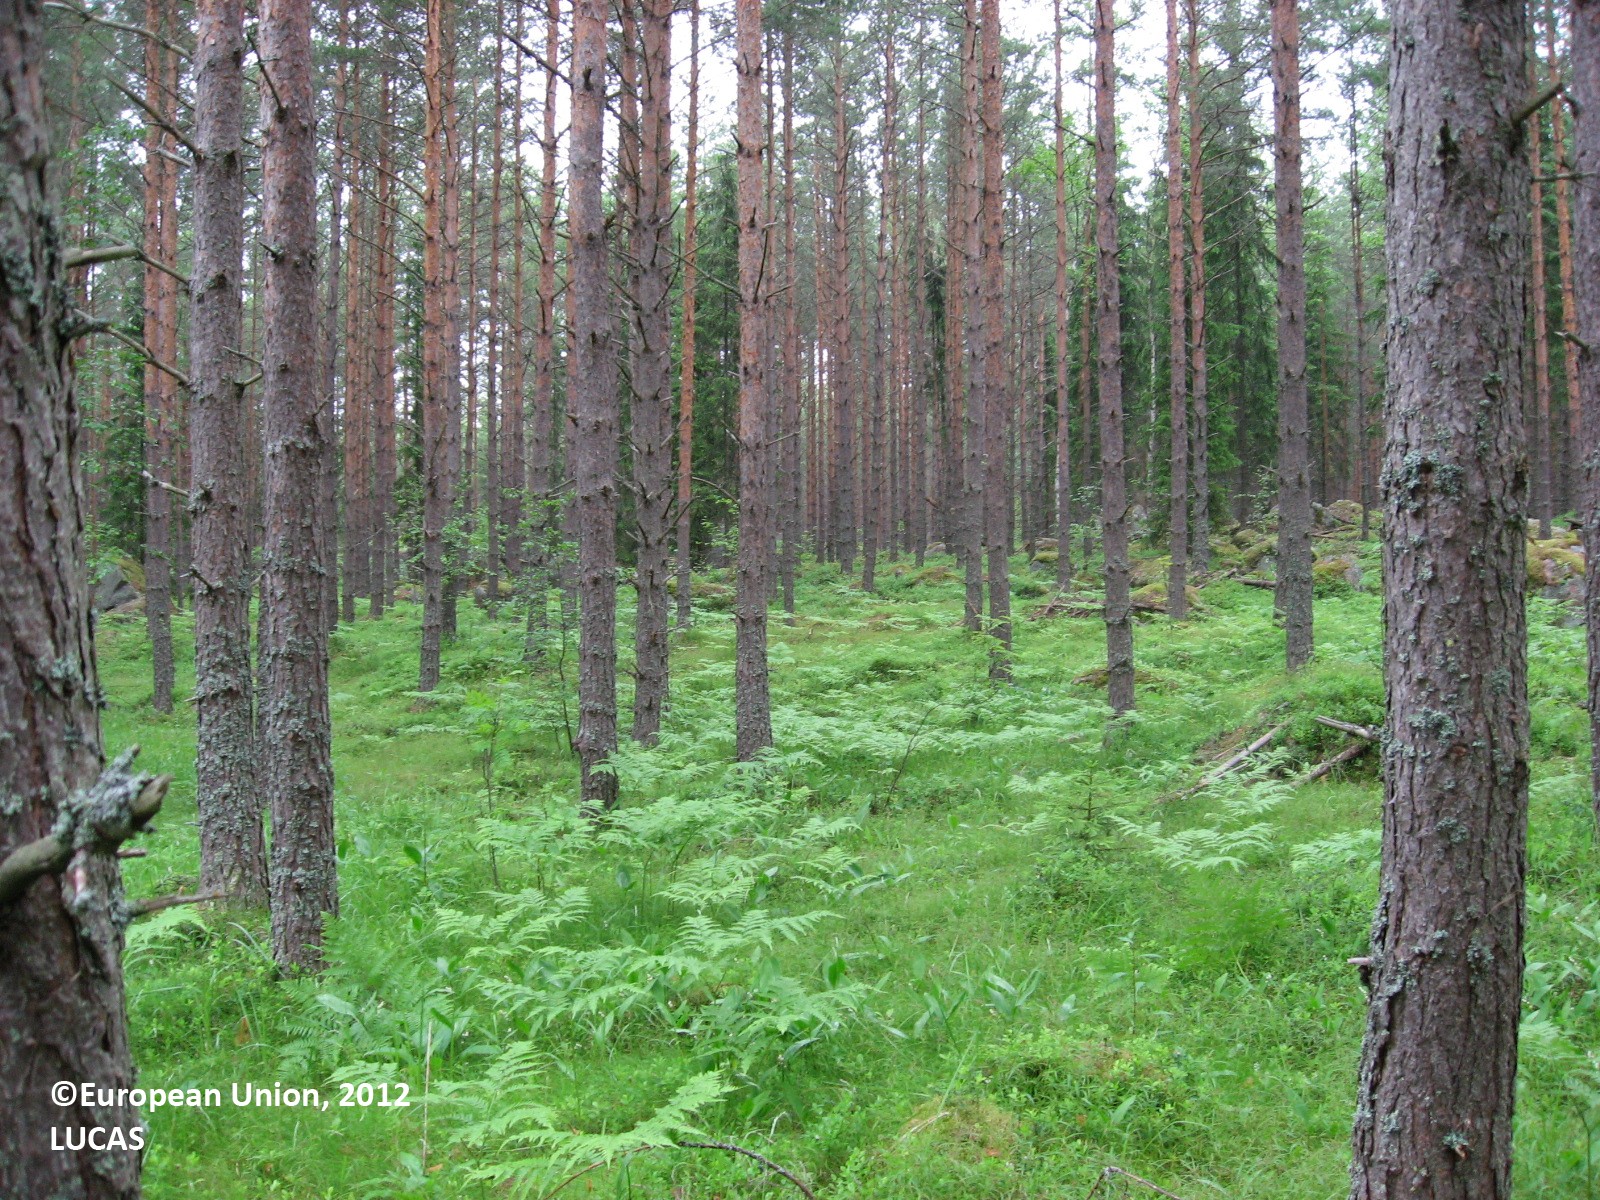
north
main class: Woodland
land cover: Pine dominated coniferous woodland
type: boreal forest
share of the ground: > 75 %
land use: Forestry
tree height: > 5 m
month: June
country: FI
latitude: 60.4825
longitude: 26.2524
